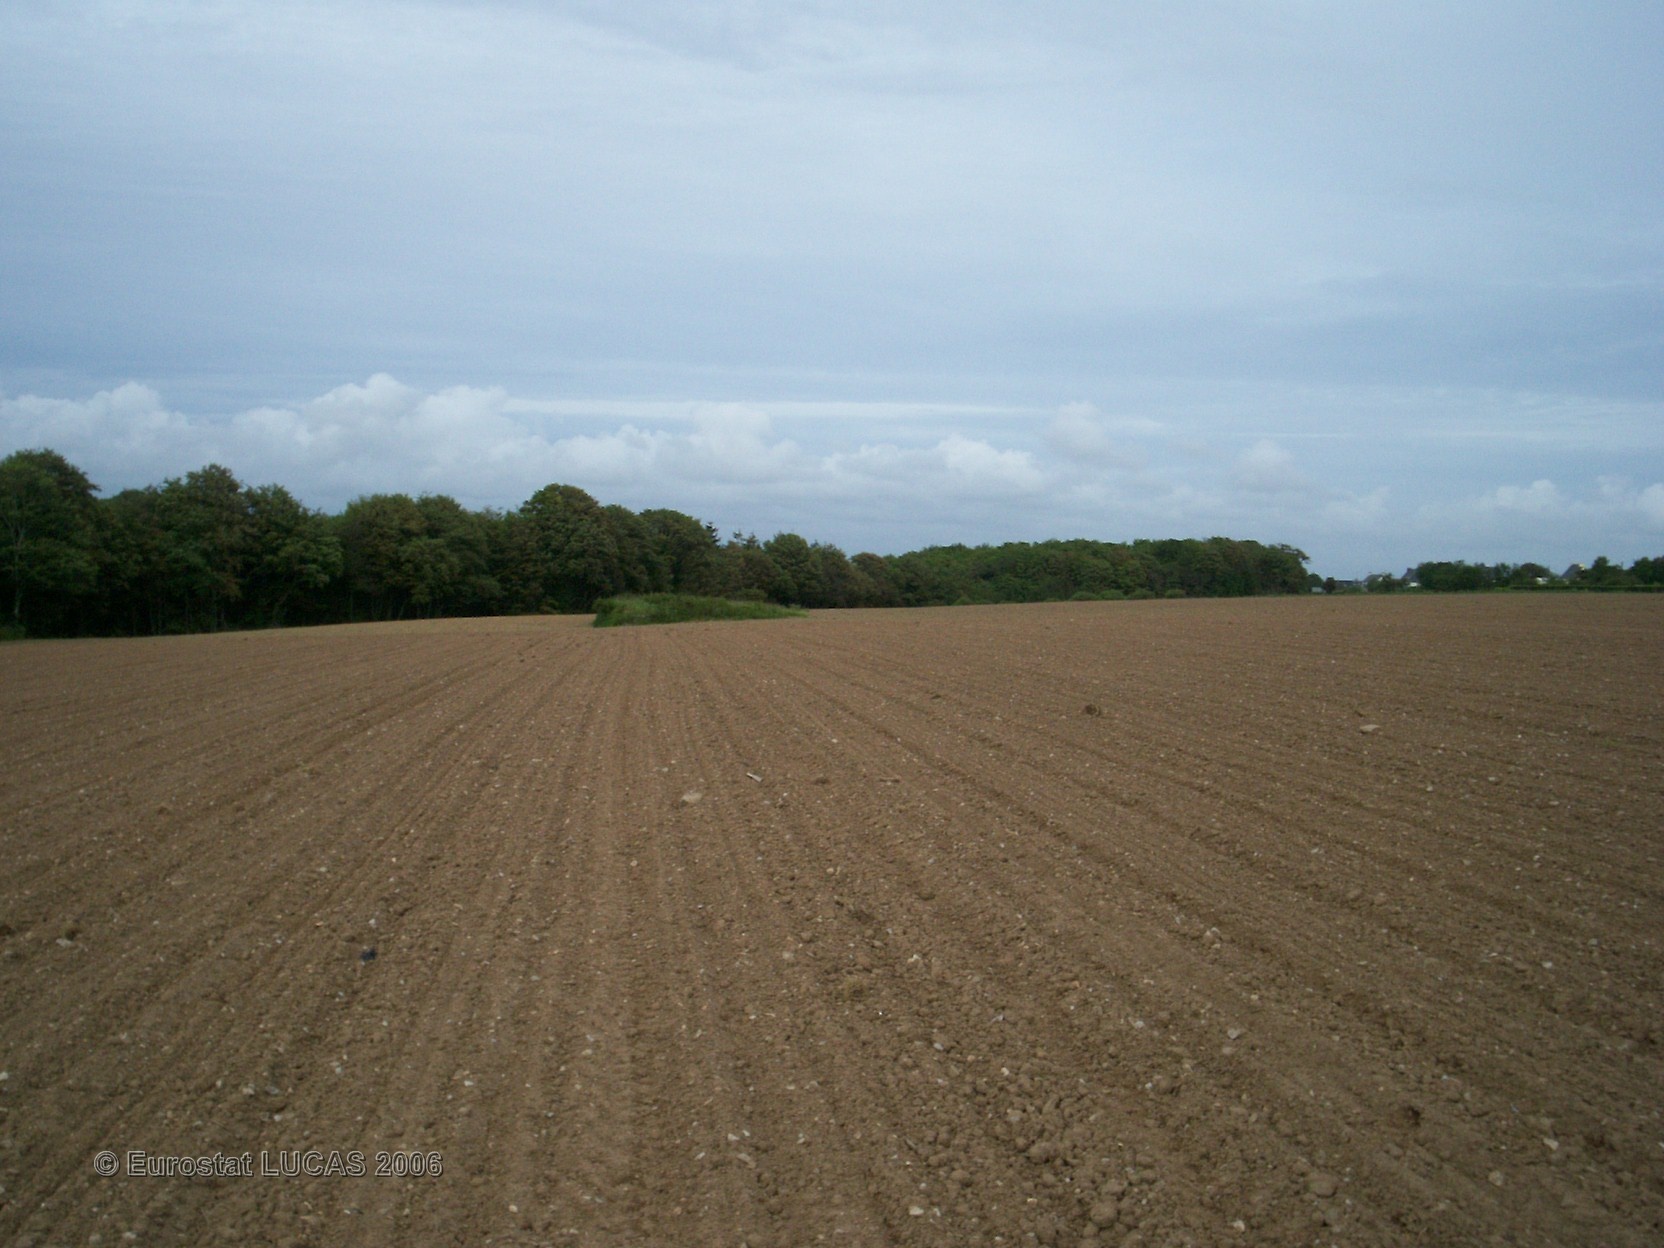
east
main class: Cropland
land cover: Maize
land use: Agriculture (excluding fallow land and kitchen gardens)
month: May
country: FR
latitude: 47.7732
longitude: -3.4862
